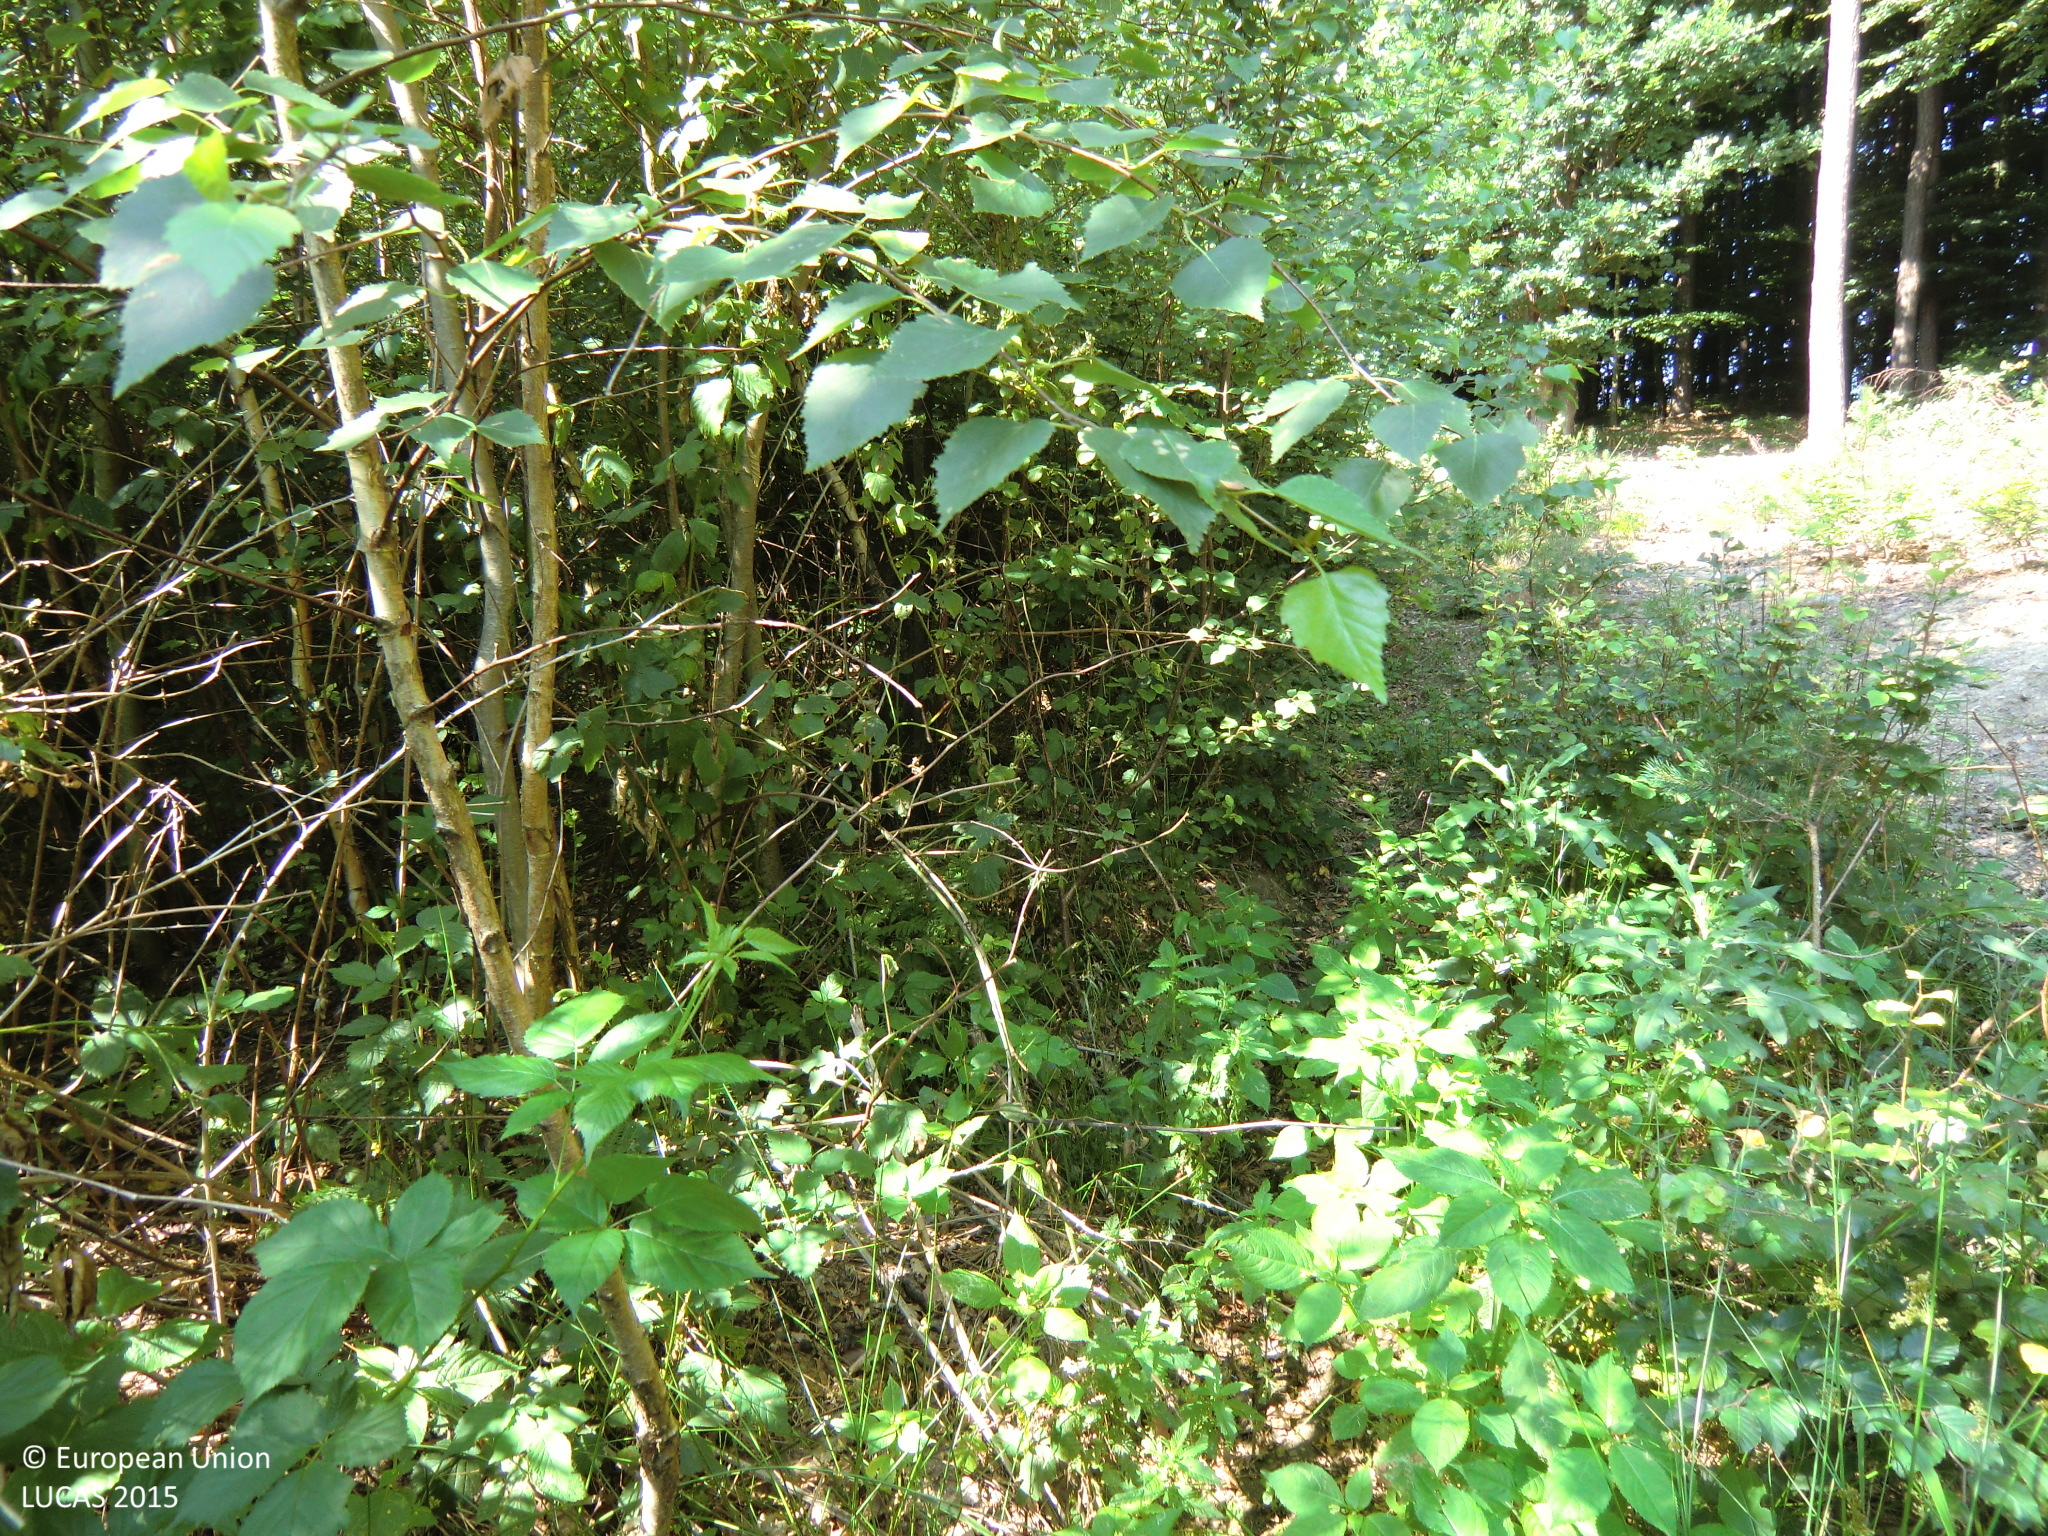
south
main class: Artificial land
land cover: Other artificial areas
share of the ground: > 75 %
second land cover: Broadleaved woodland
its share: > 75 %
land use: Electricity, gas and thermal power distribution
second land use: Forestry
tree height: > 5 m
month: July
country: AT
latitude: 47.2487
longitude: 15.9868
